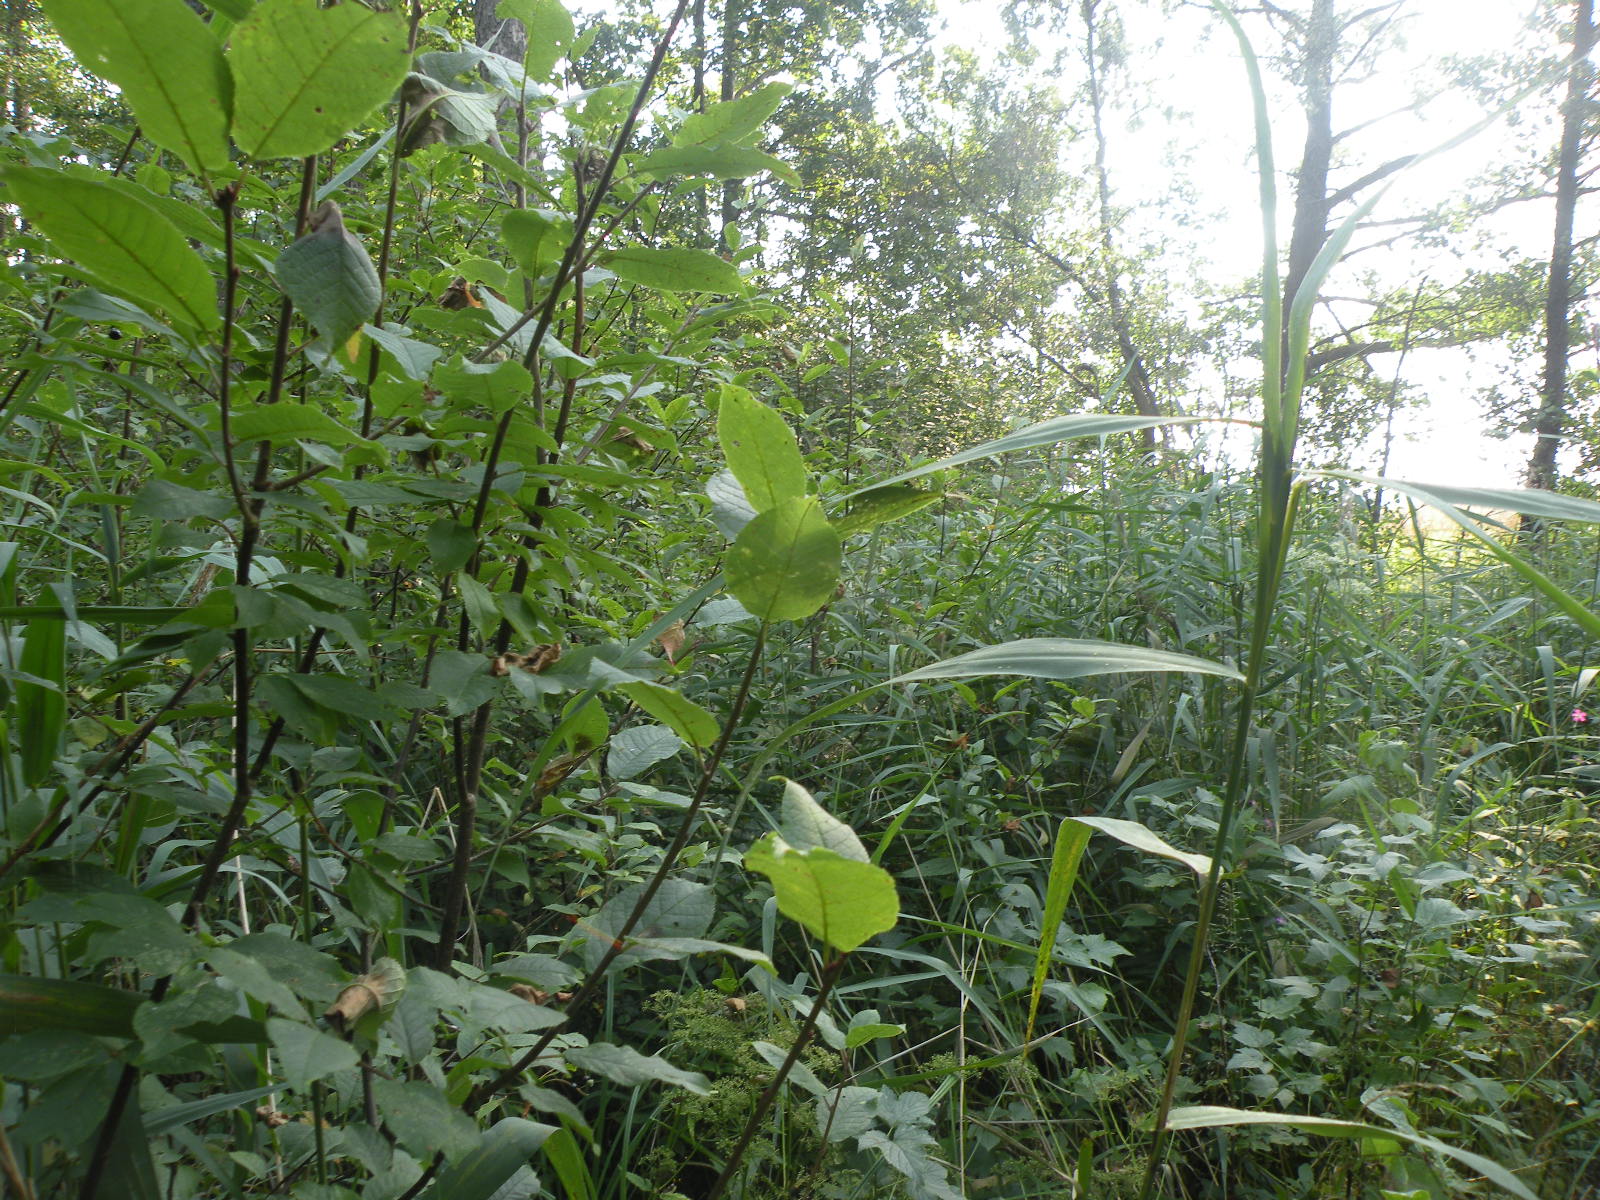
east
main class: Woodland
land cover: Broadleaved woodland
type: floodplain forest
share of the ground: > 75 %
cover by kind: broadleaved forest trees 80 %, herbaceous plants 20 %
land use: Forestry
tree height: > 5 m
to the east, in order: Broadleaved woodland; Ditches and canals; Oats; Ditches and canals; Broadleaved woodland; Ditches and canals; Broadleaved woodland; Spruce dominated mixed woodland
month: August
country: LV
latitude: 55.7514
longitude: 26.6457
